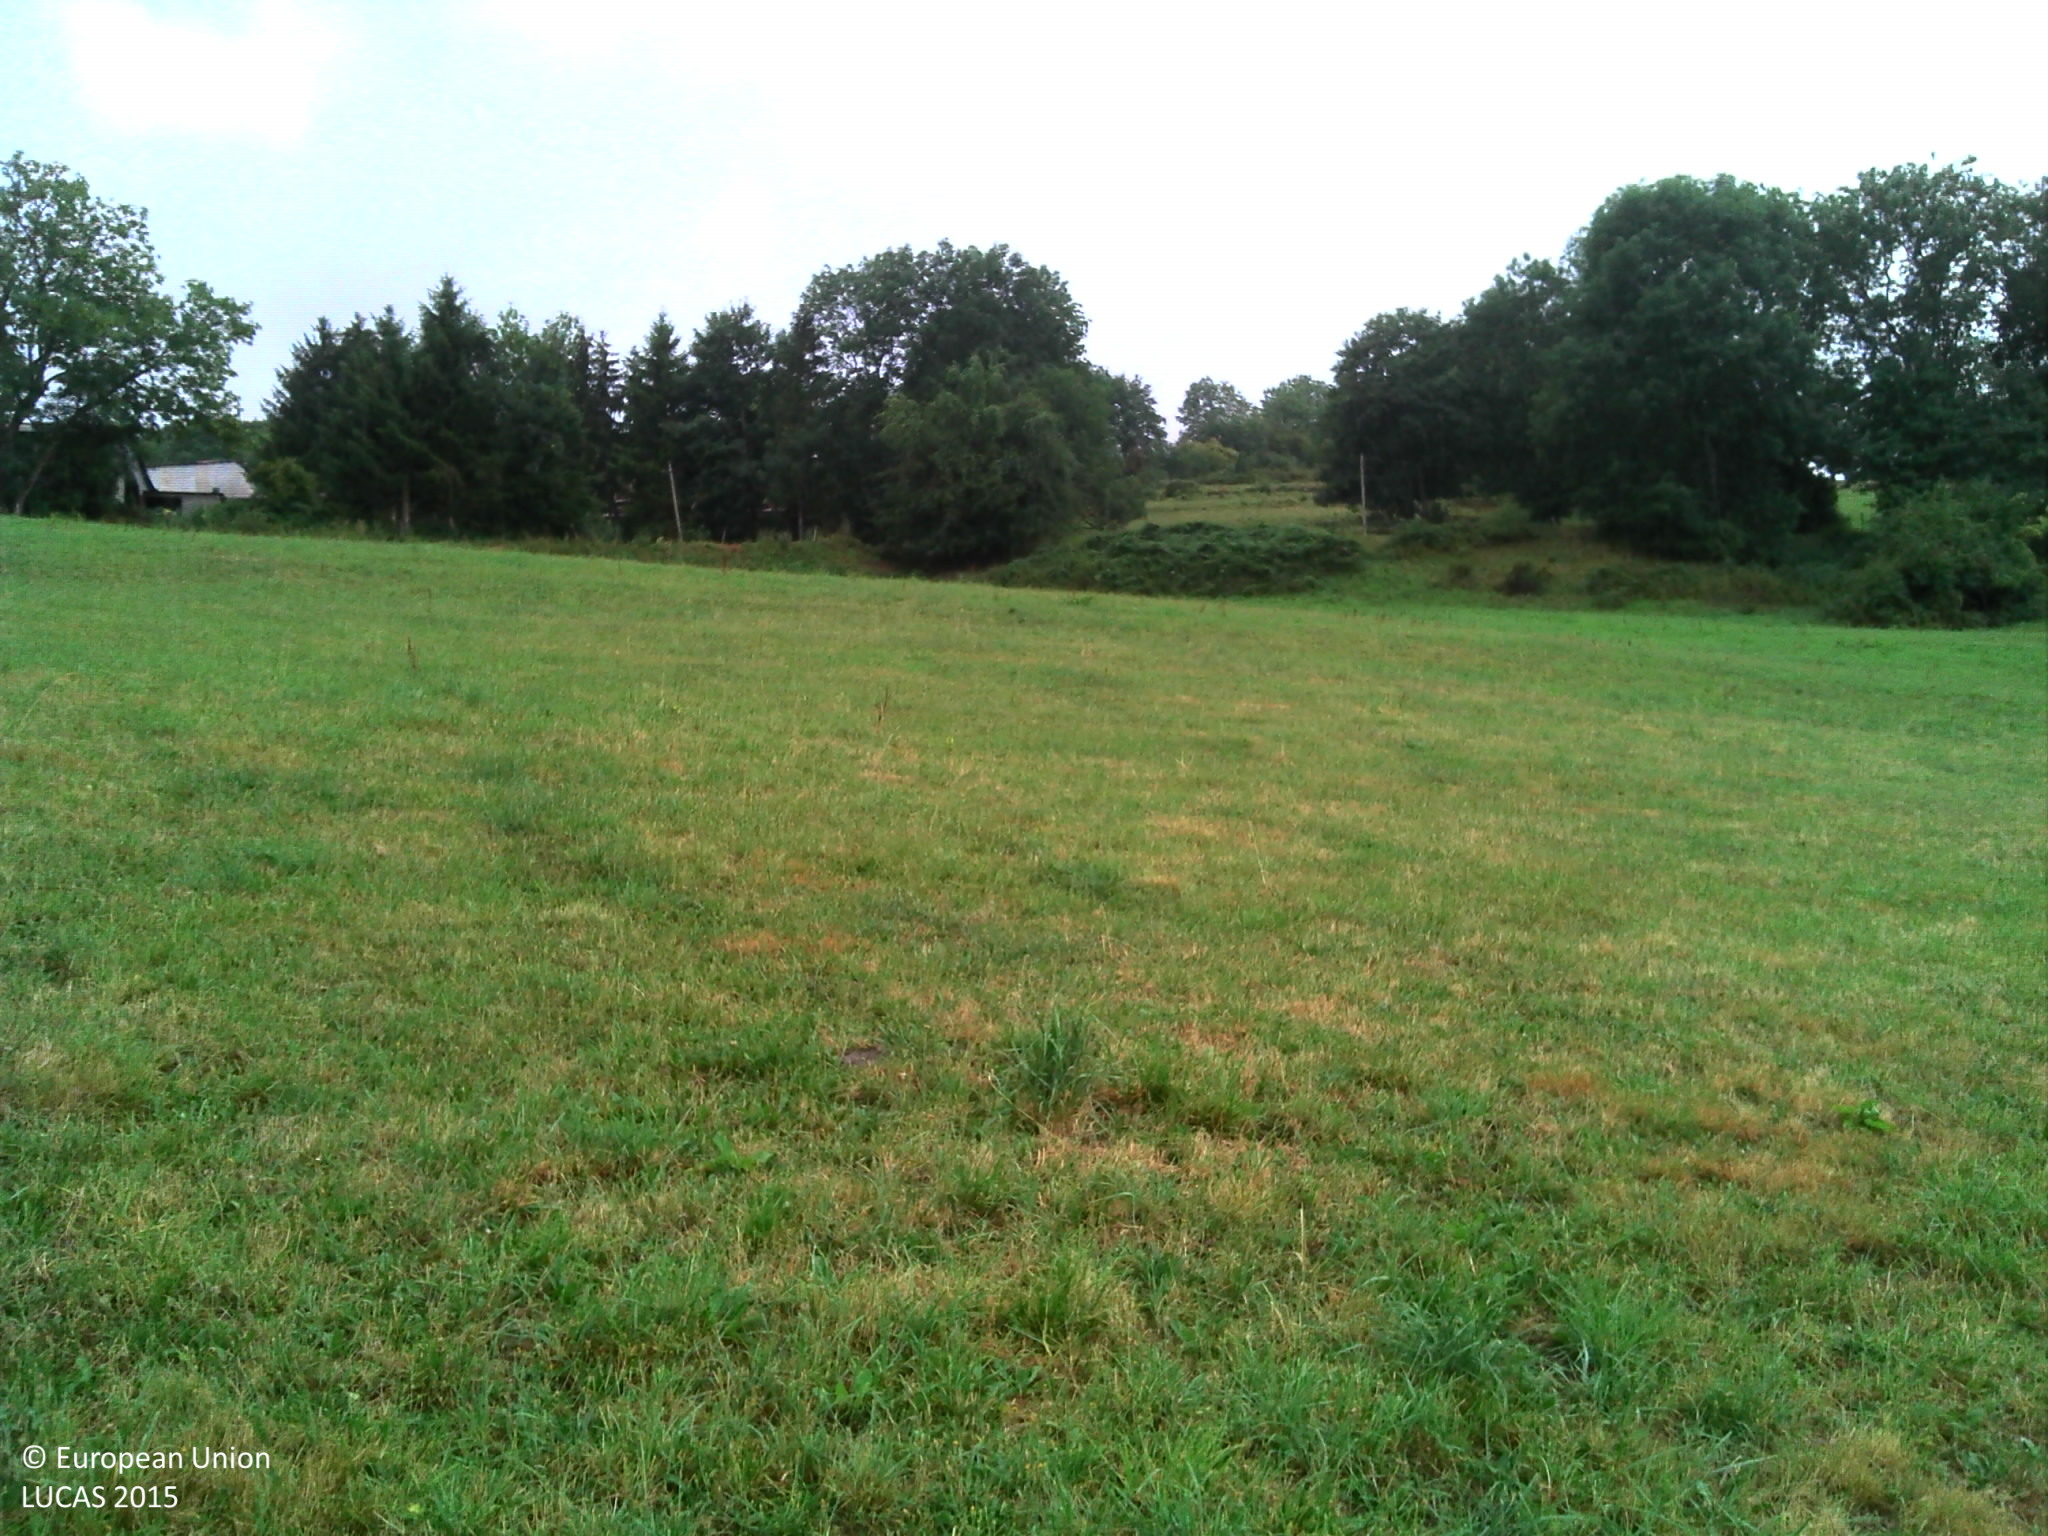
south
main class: Grassland
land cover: Grassland without tree/shrub cover
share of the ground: > 75 %
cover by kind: herbaceous plants 100 %
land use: Agriculture (excluding fallow land and kitchen gardens)
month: August
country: FR
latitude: 45.2713
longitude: 4.5108
